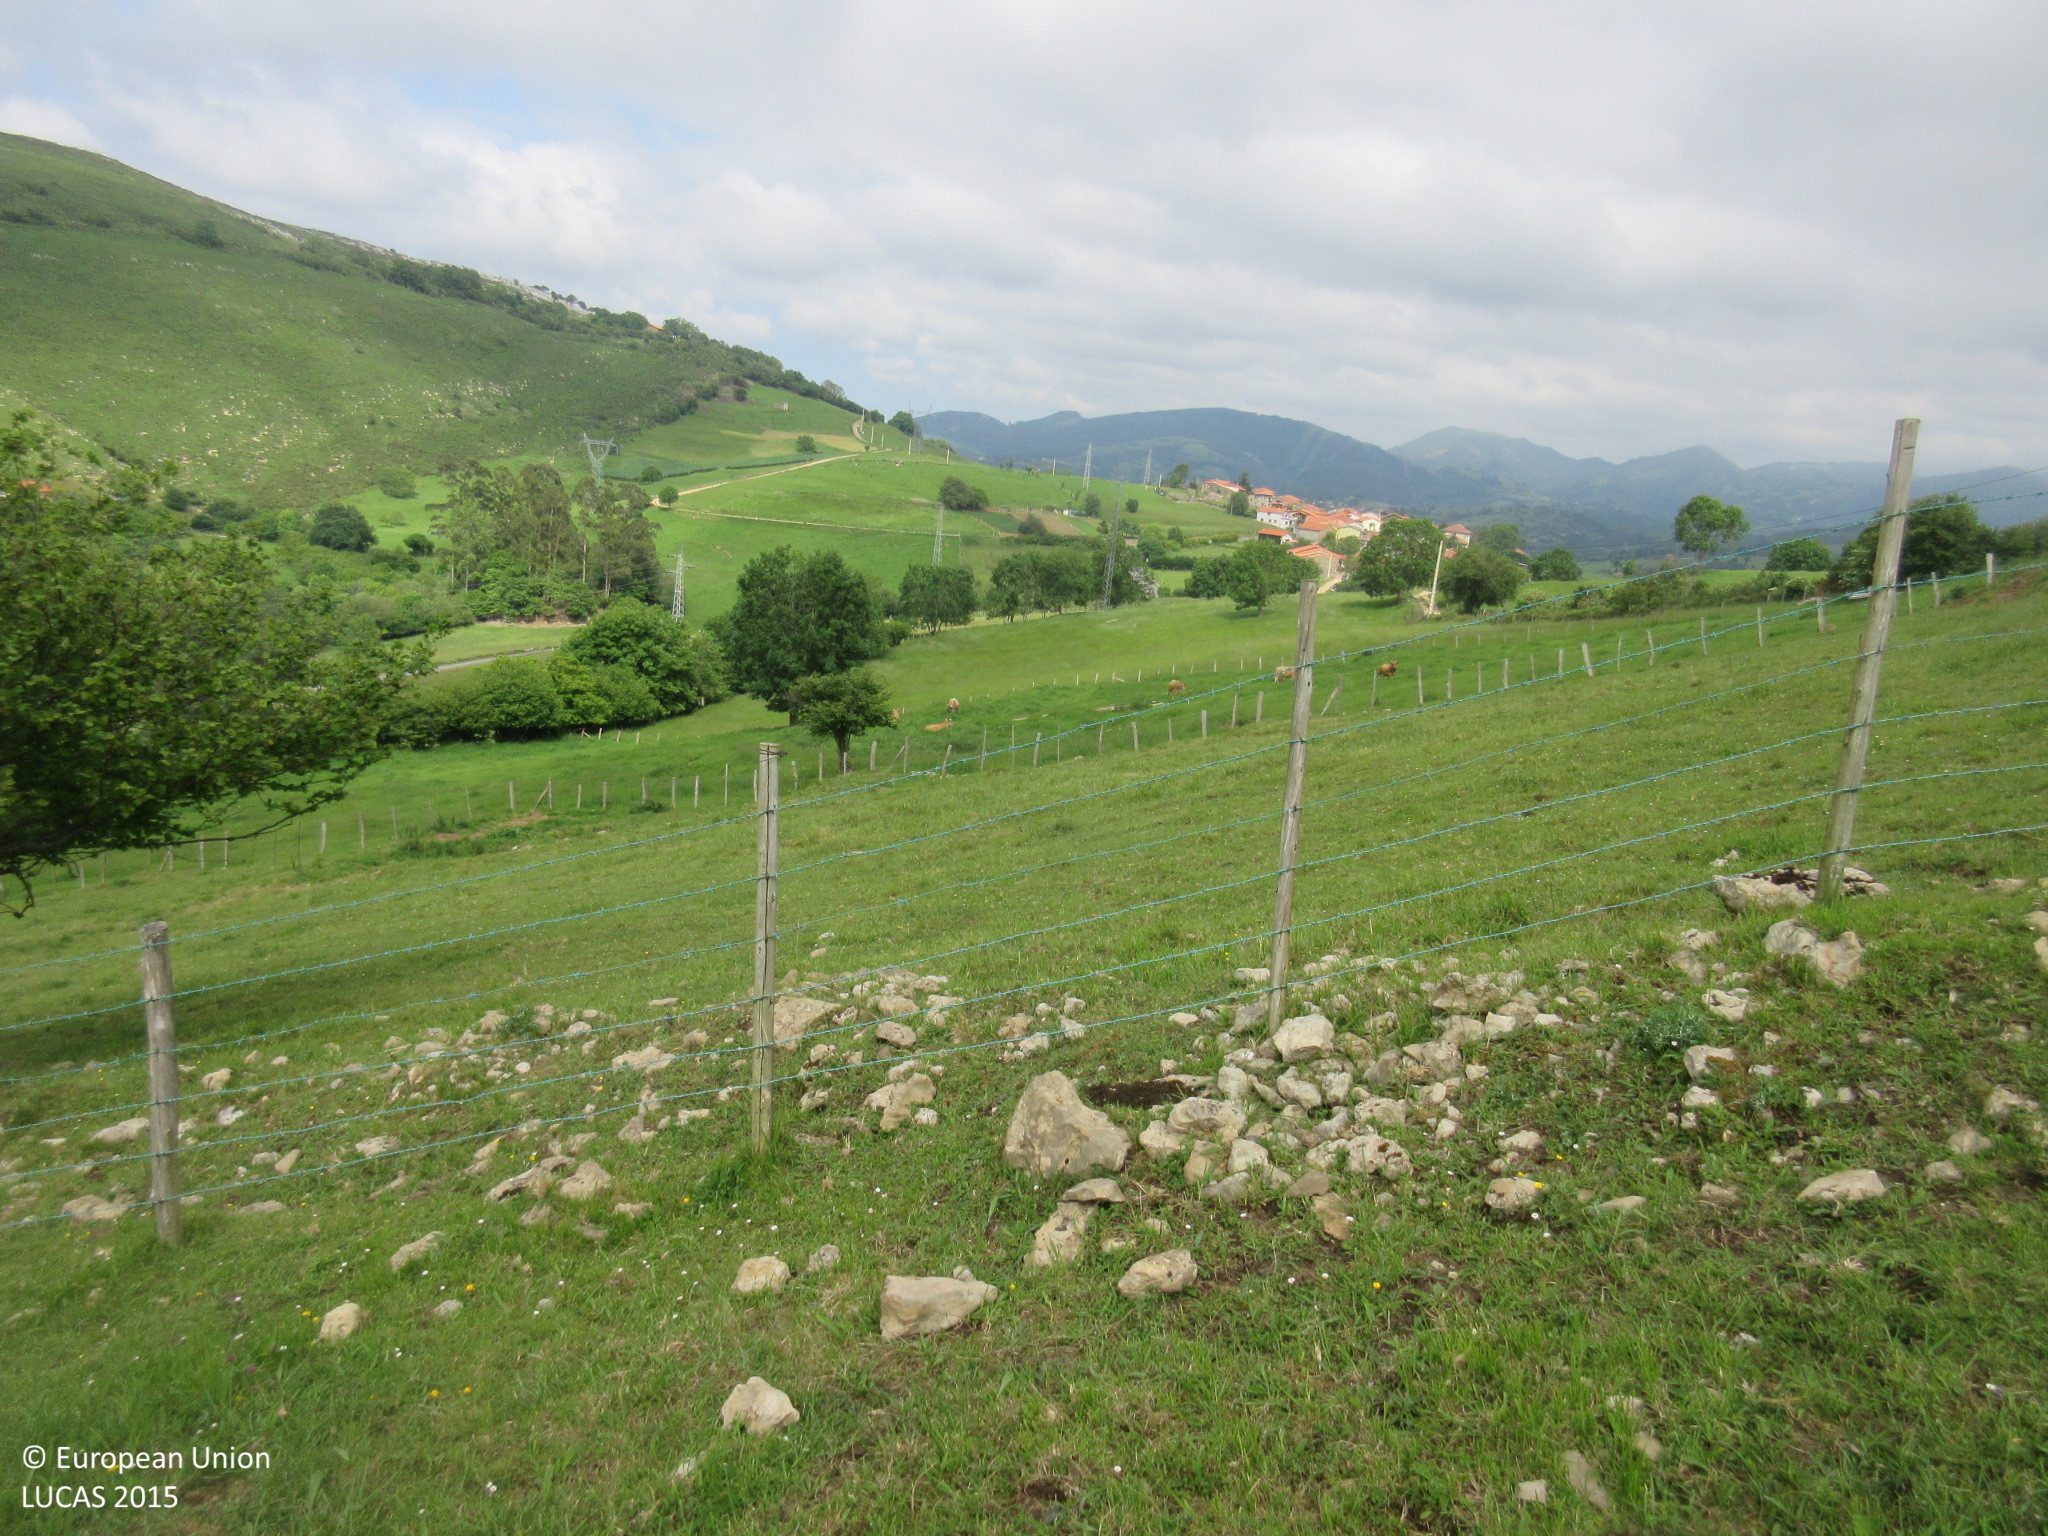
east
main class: Grassland
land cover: Grassland without tree/shrub cover
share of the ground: > 75 %
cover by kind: herbaceous plants 100 %
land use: Agriculture (excluding fallow land and kitchen gardens)
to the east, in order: Grassland without tree/shrub cover; Fences; Grassland without tree/shrub cover; Fences; Grassland without tree/shrub cover; Fences; Grass margins; Tracks; Electric lines; Grass margins; Fences; Groves; Grassland without tree/shrub cover
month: May
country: ES
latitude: 43.3187
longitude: -4.5492
